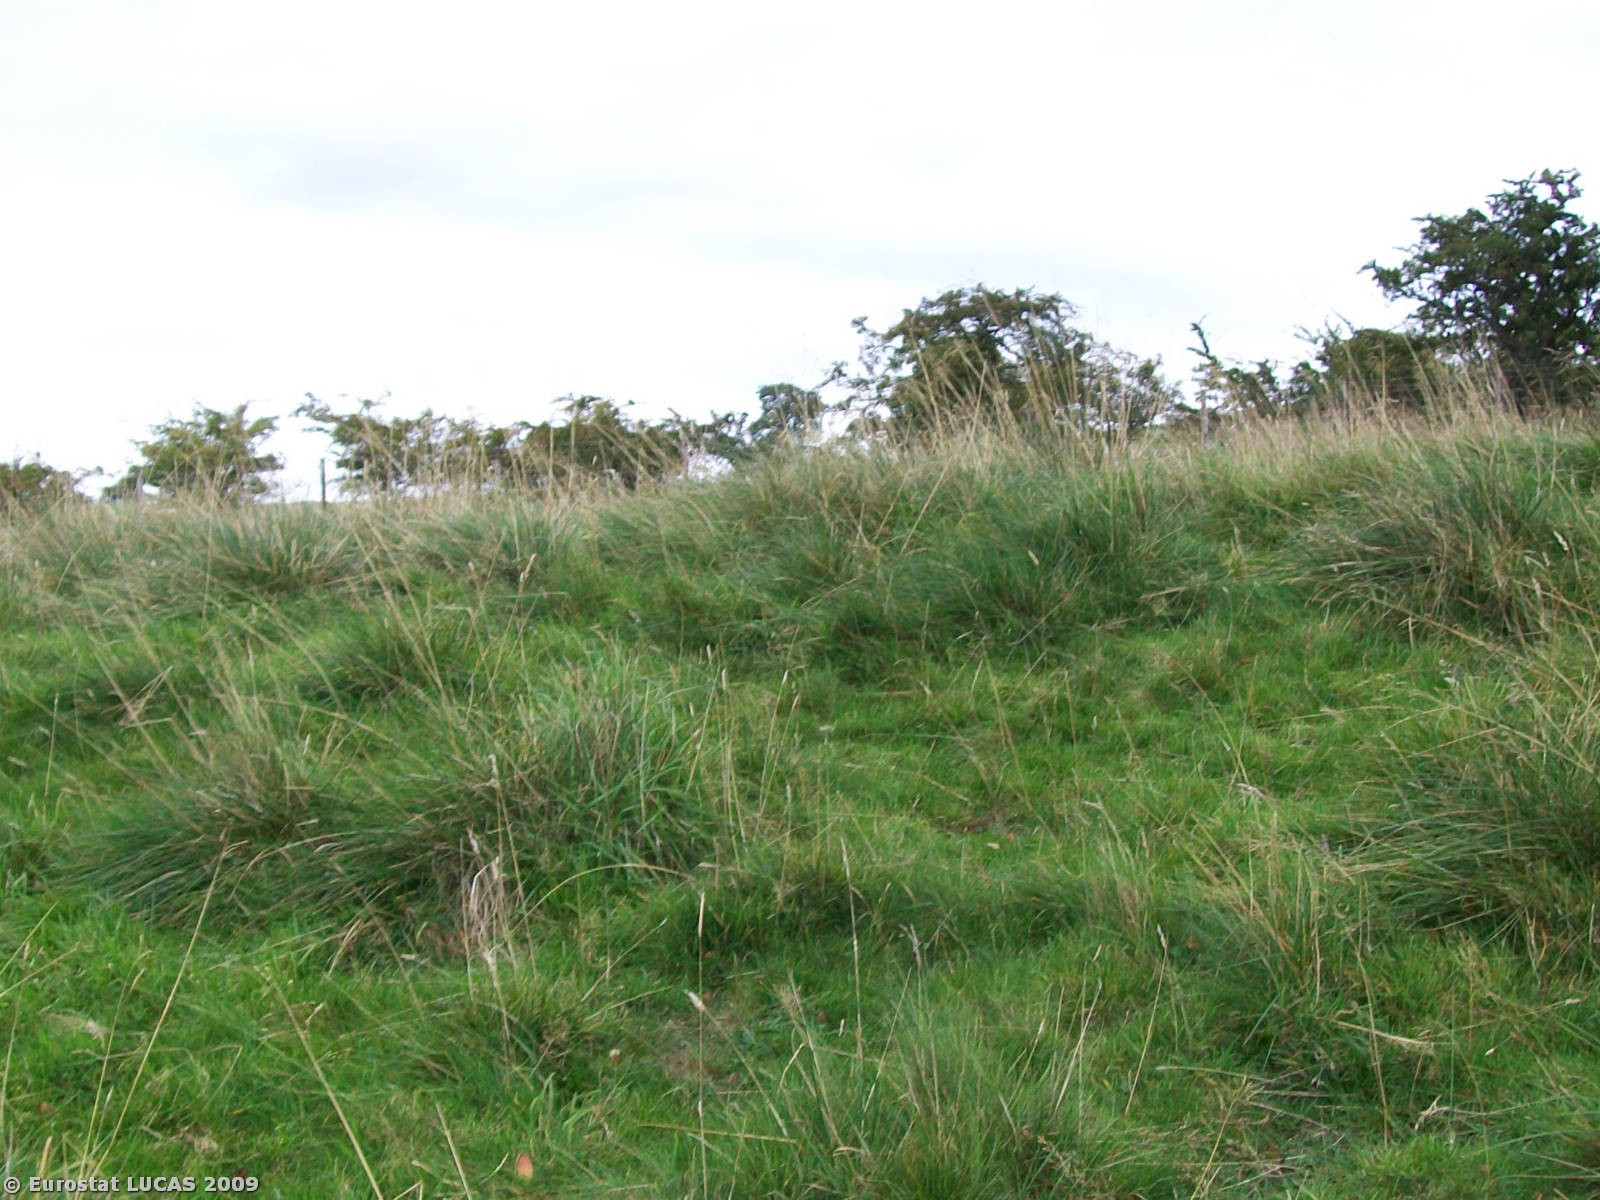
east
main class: Woodland
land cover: Broadleaved woodland
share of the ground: > 75 %
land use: Agriculture (excluding fallow land and kitchen gardens)
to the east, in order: Broadleaved woodland; Grassland without tree/shrub cover; Fences; Lines of trees; Tracks; Lines of trees; Fences; Grassland without tree/shrub cover
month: September
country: GB
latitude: 55.0315
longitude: -2.0870
